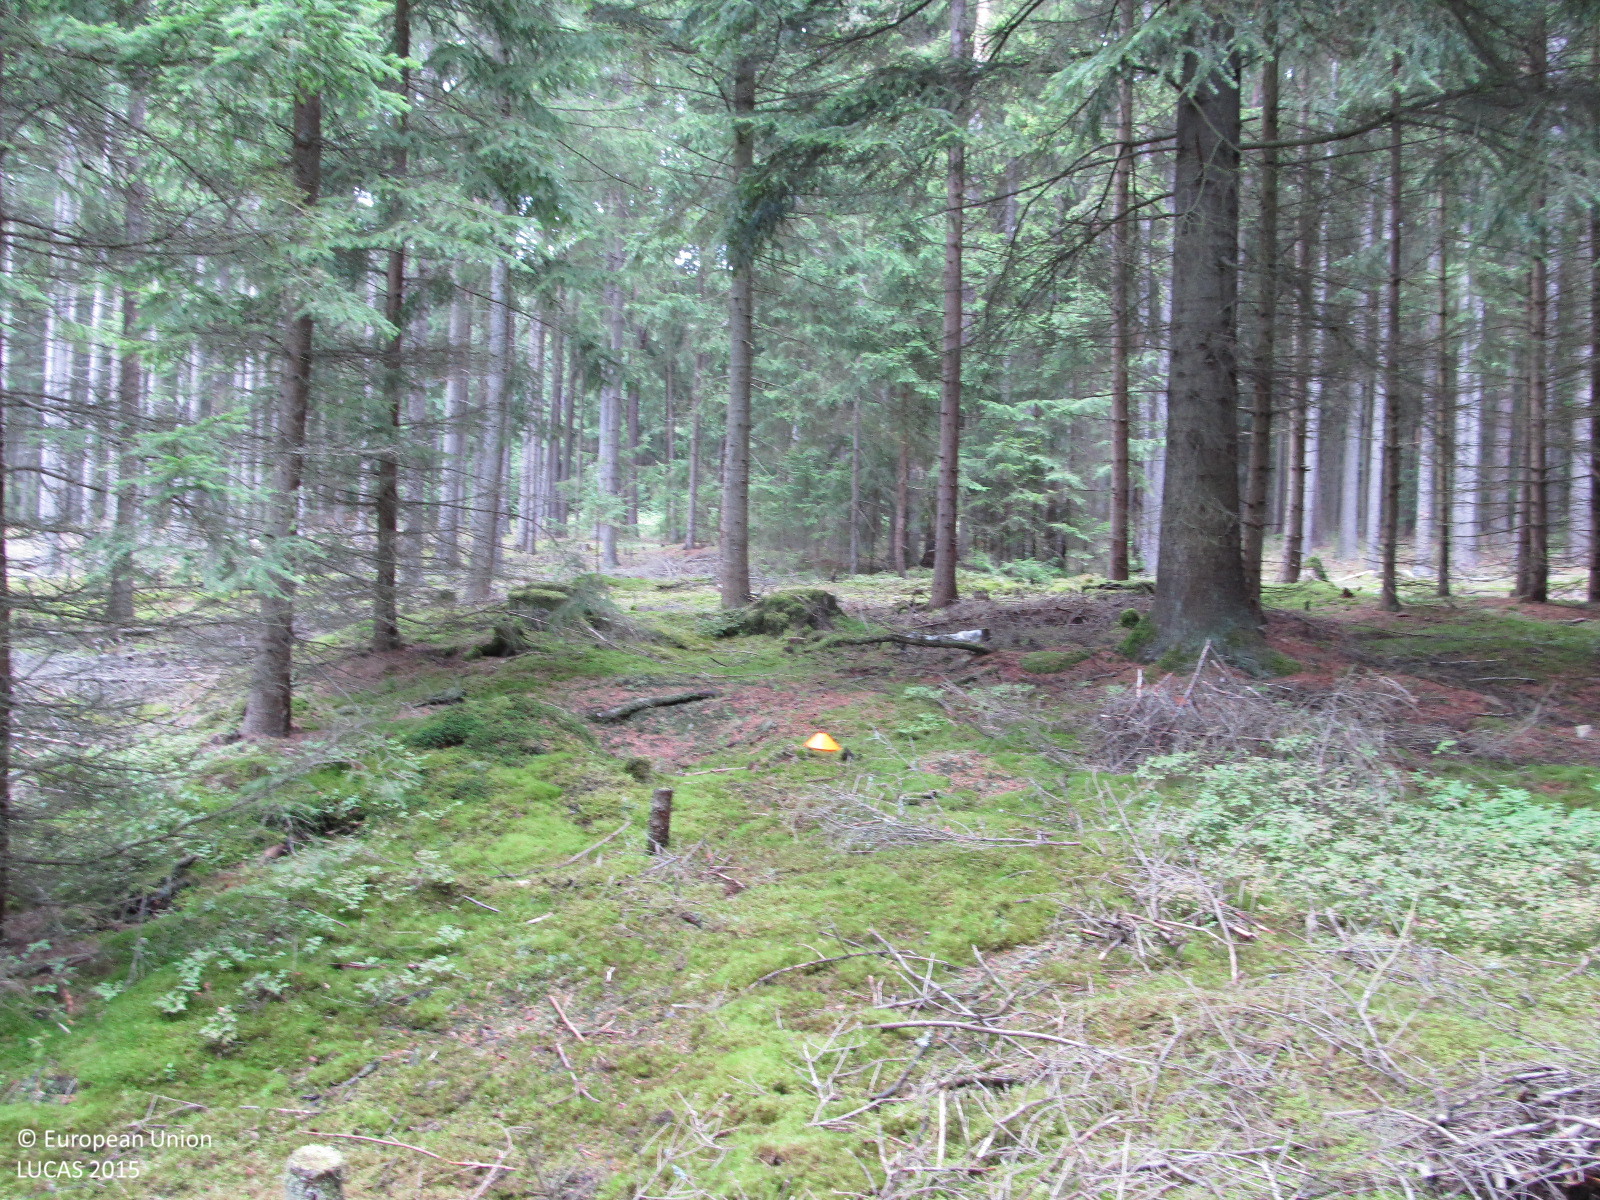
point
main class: Woodland
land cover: Spruce dominated coniferous woodland
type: hemiboreal forest and nemoral coniferous forest and mixed broadleaved-coniferous forest
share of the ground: > 75 %
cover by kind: coniferous forest trees 80 %, herbaceous plants 10 %, lichens and mosses 10 %
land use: Forestry
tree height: > 5 m
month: September
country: AT
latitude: 48.9761
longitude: 15.3723
